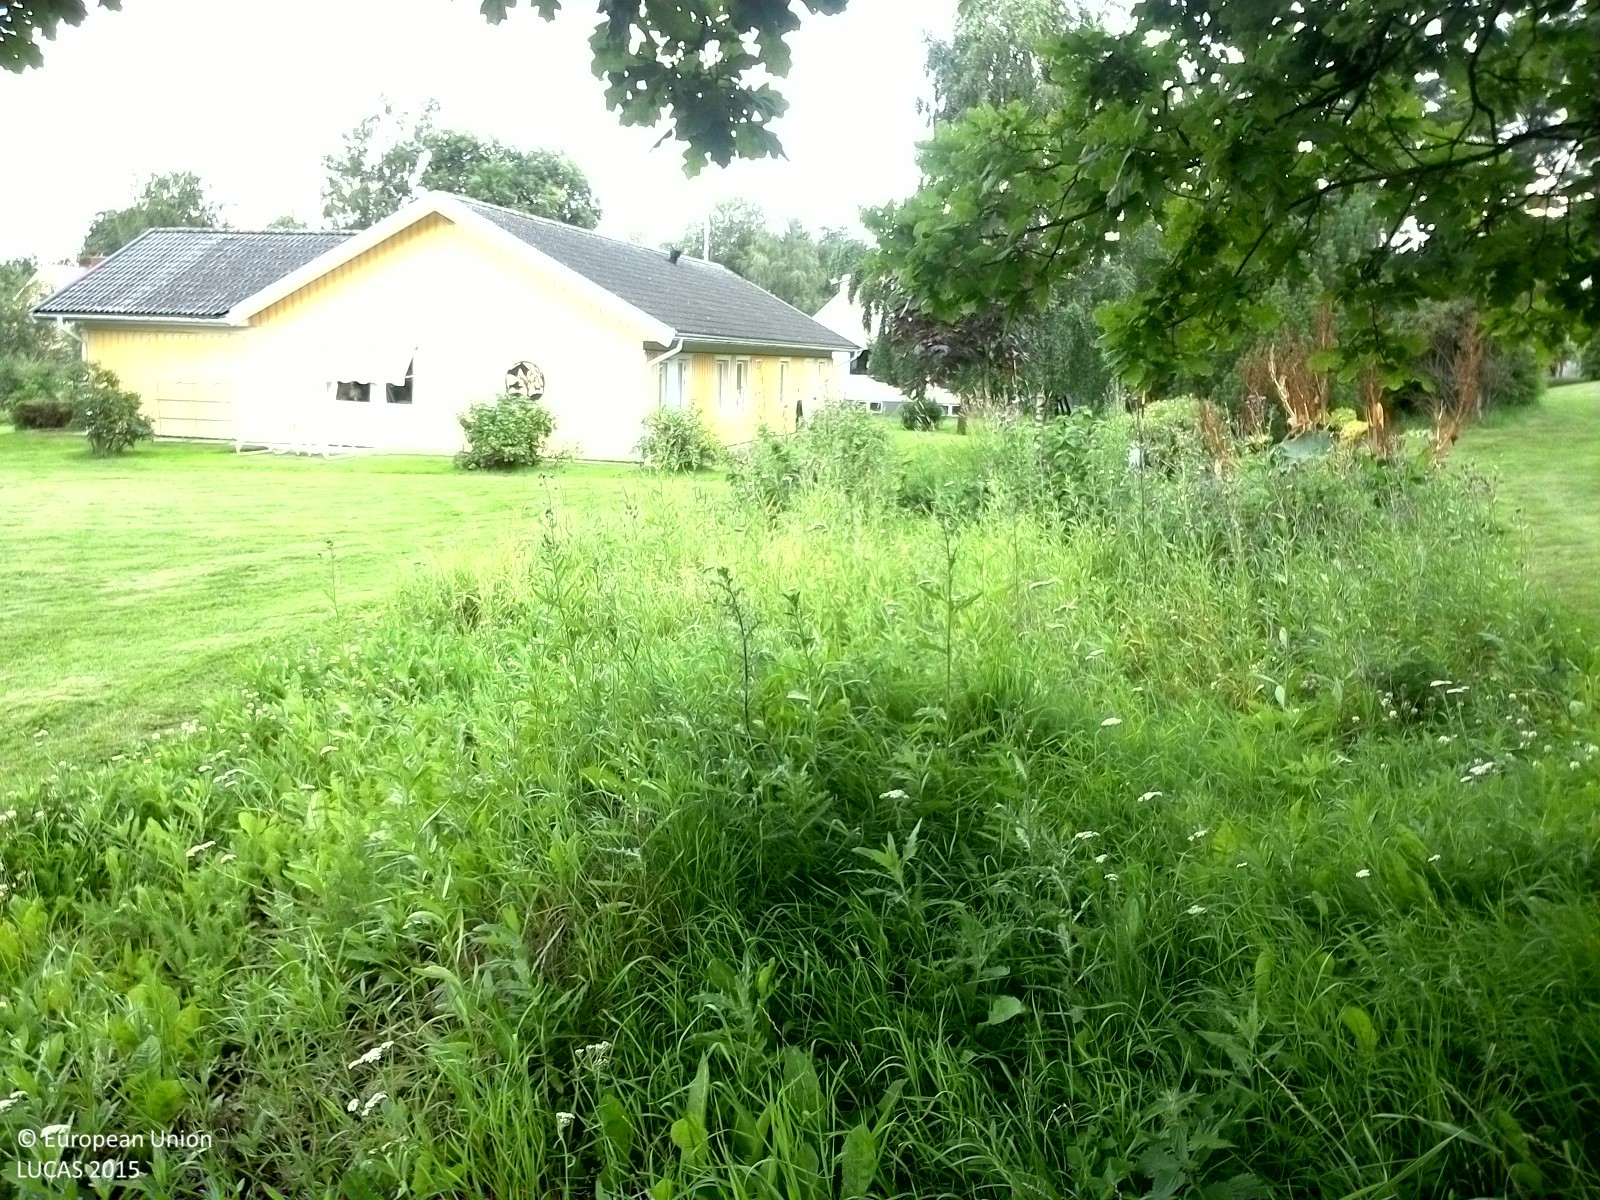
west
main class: Grassland
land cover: Grassland without tree/shrub cover
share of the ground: > 75 %
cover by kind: herbaceous plants 100 %
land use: Residential
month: August
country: SE
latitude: 62.4144
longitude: 17.3555
